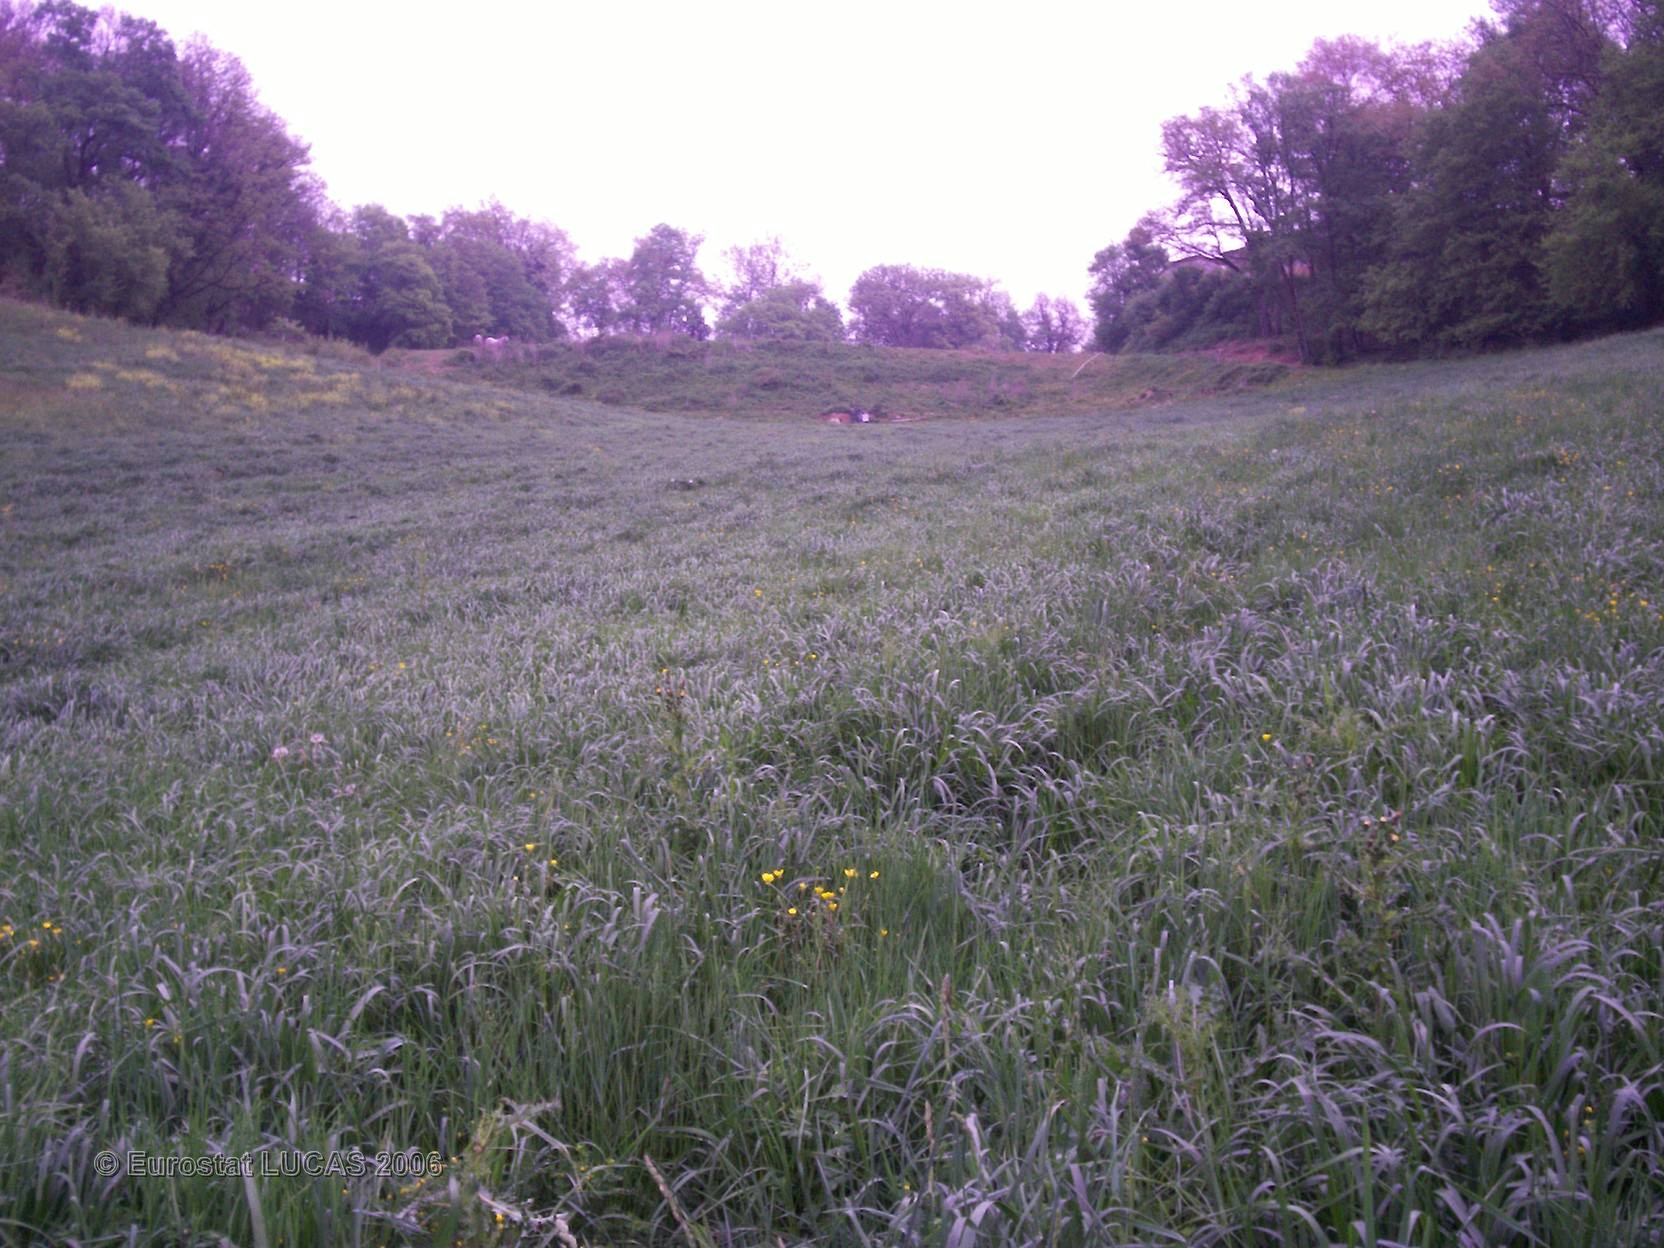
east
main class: Grassland
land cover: Grassland without tree/shrub cover
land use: Agriculture (excluding fallow land and kitchen gardens)
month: April
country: FR
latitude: 44.2196
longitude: 0.8712
